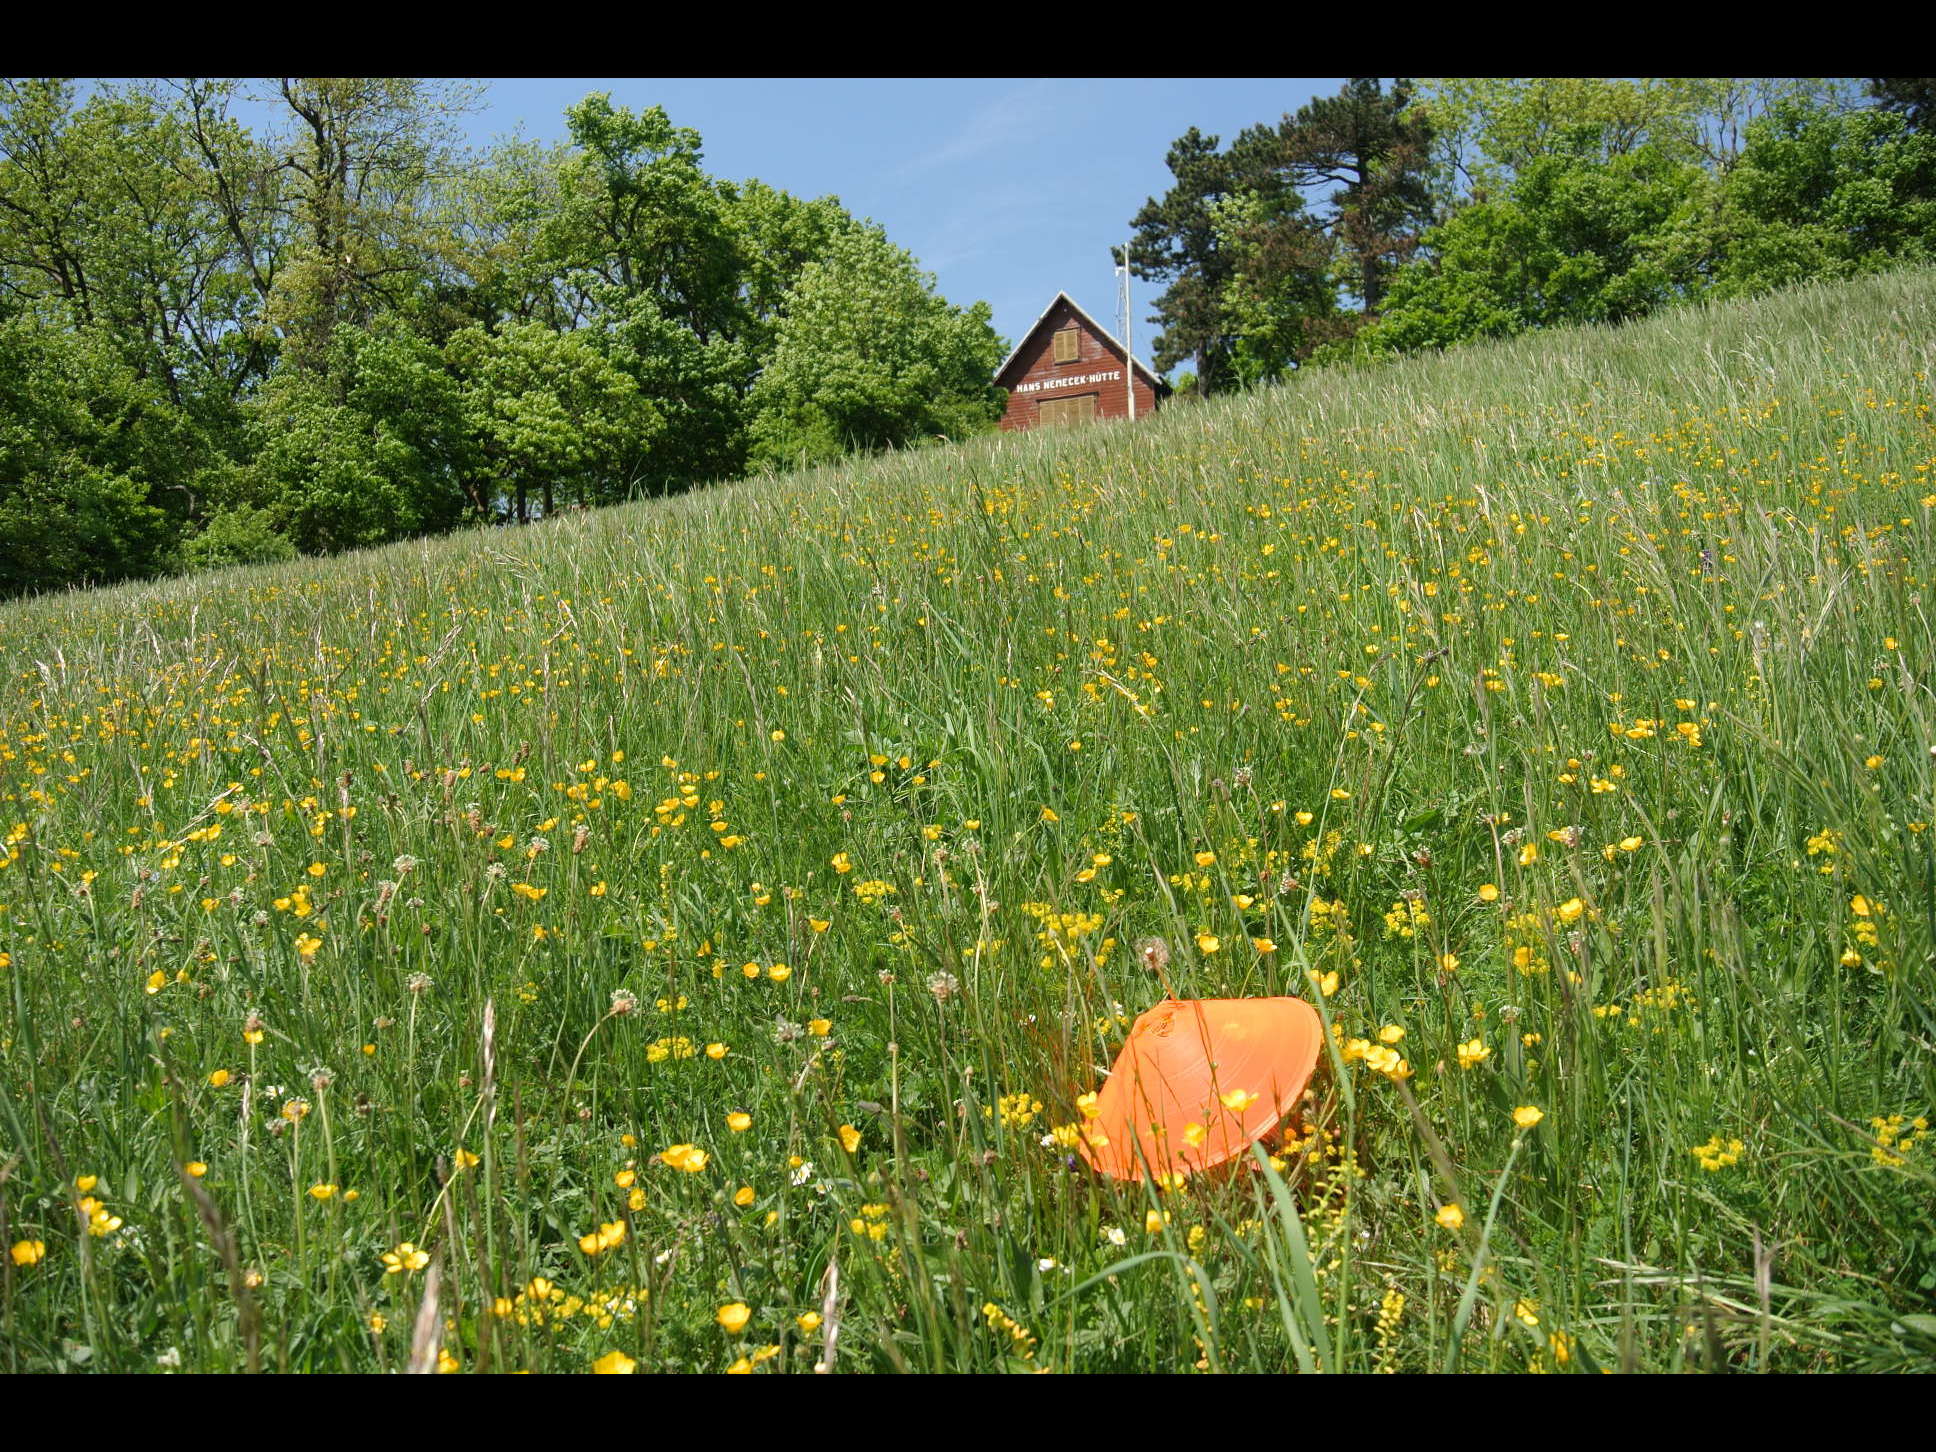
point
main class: Grassland
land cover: Grassland without tree/shrub cover
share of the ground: > 75 %
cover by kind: herbaceous plants 100 %
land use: Agriculture (excluding fallow land and kitchen gardens)
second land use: Amenities, museums, leisure
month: May
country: AT
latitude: 48.1019
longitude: 16.2219
